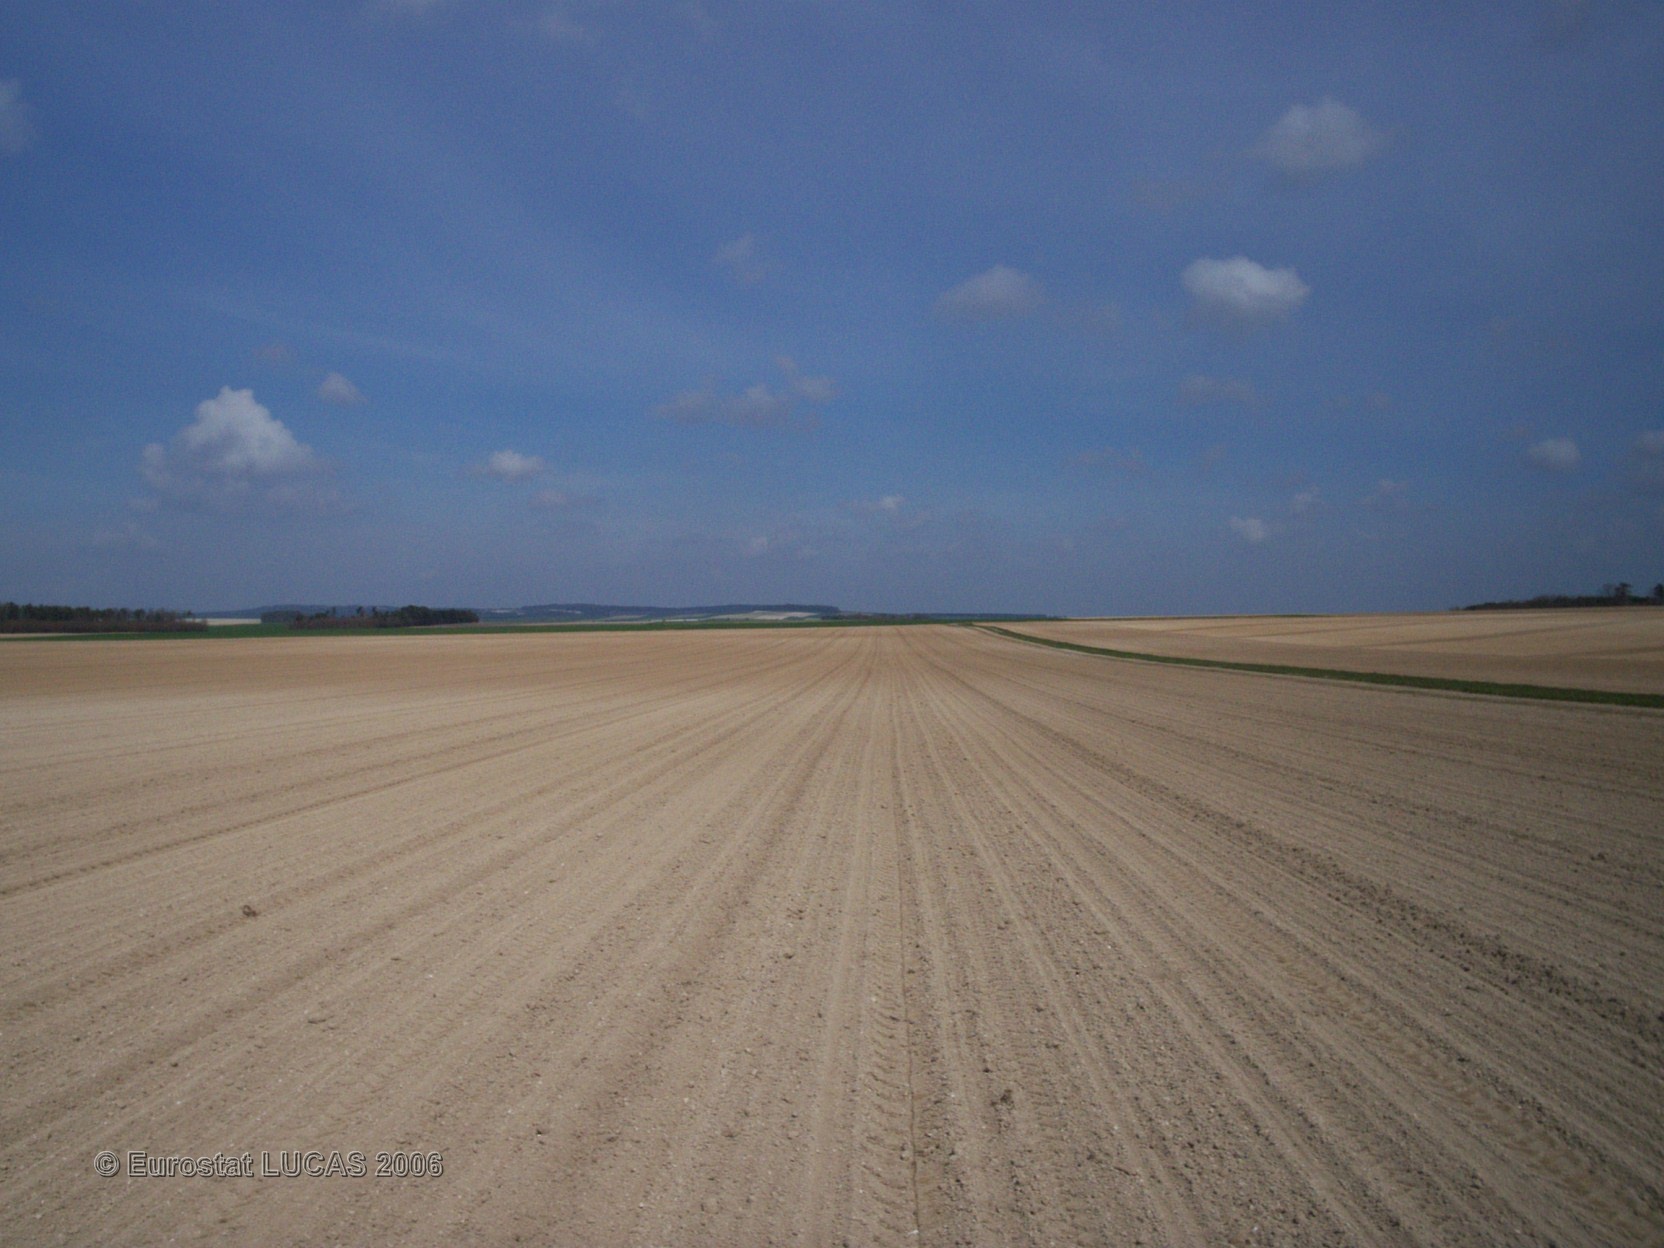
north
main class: Cropland
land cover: Sugar beet
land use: Agriculture (excluding fallow land and kitchen gardens)
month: June
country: FR
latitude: 49.1626
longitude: 4.3873
